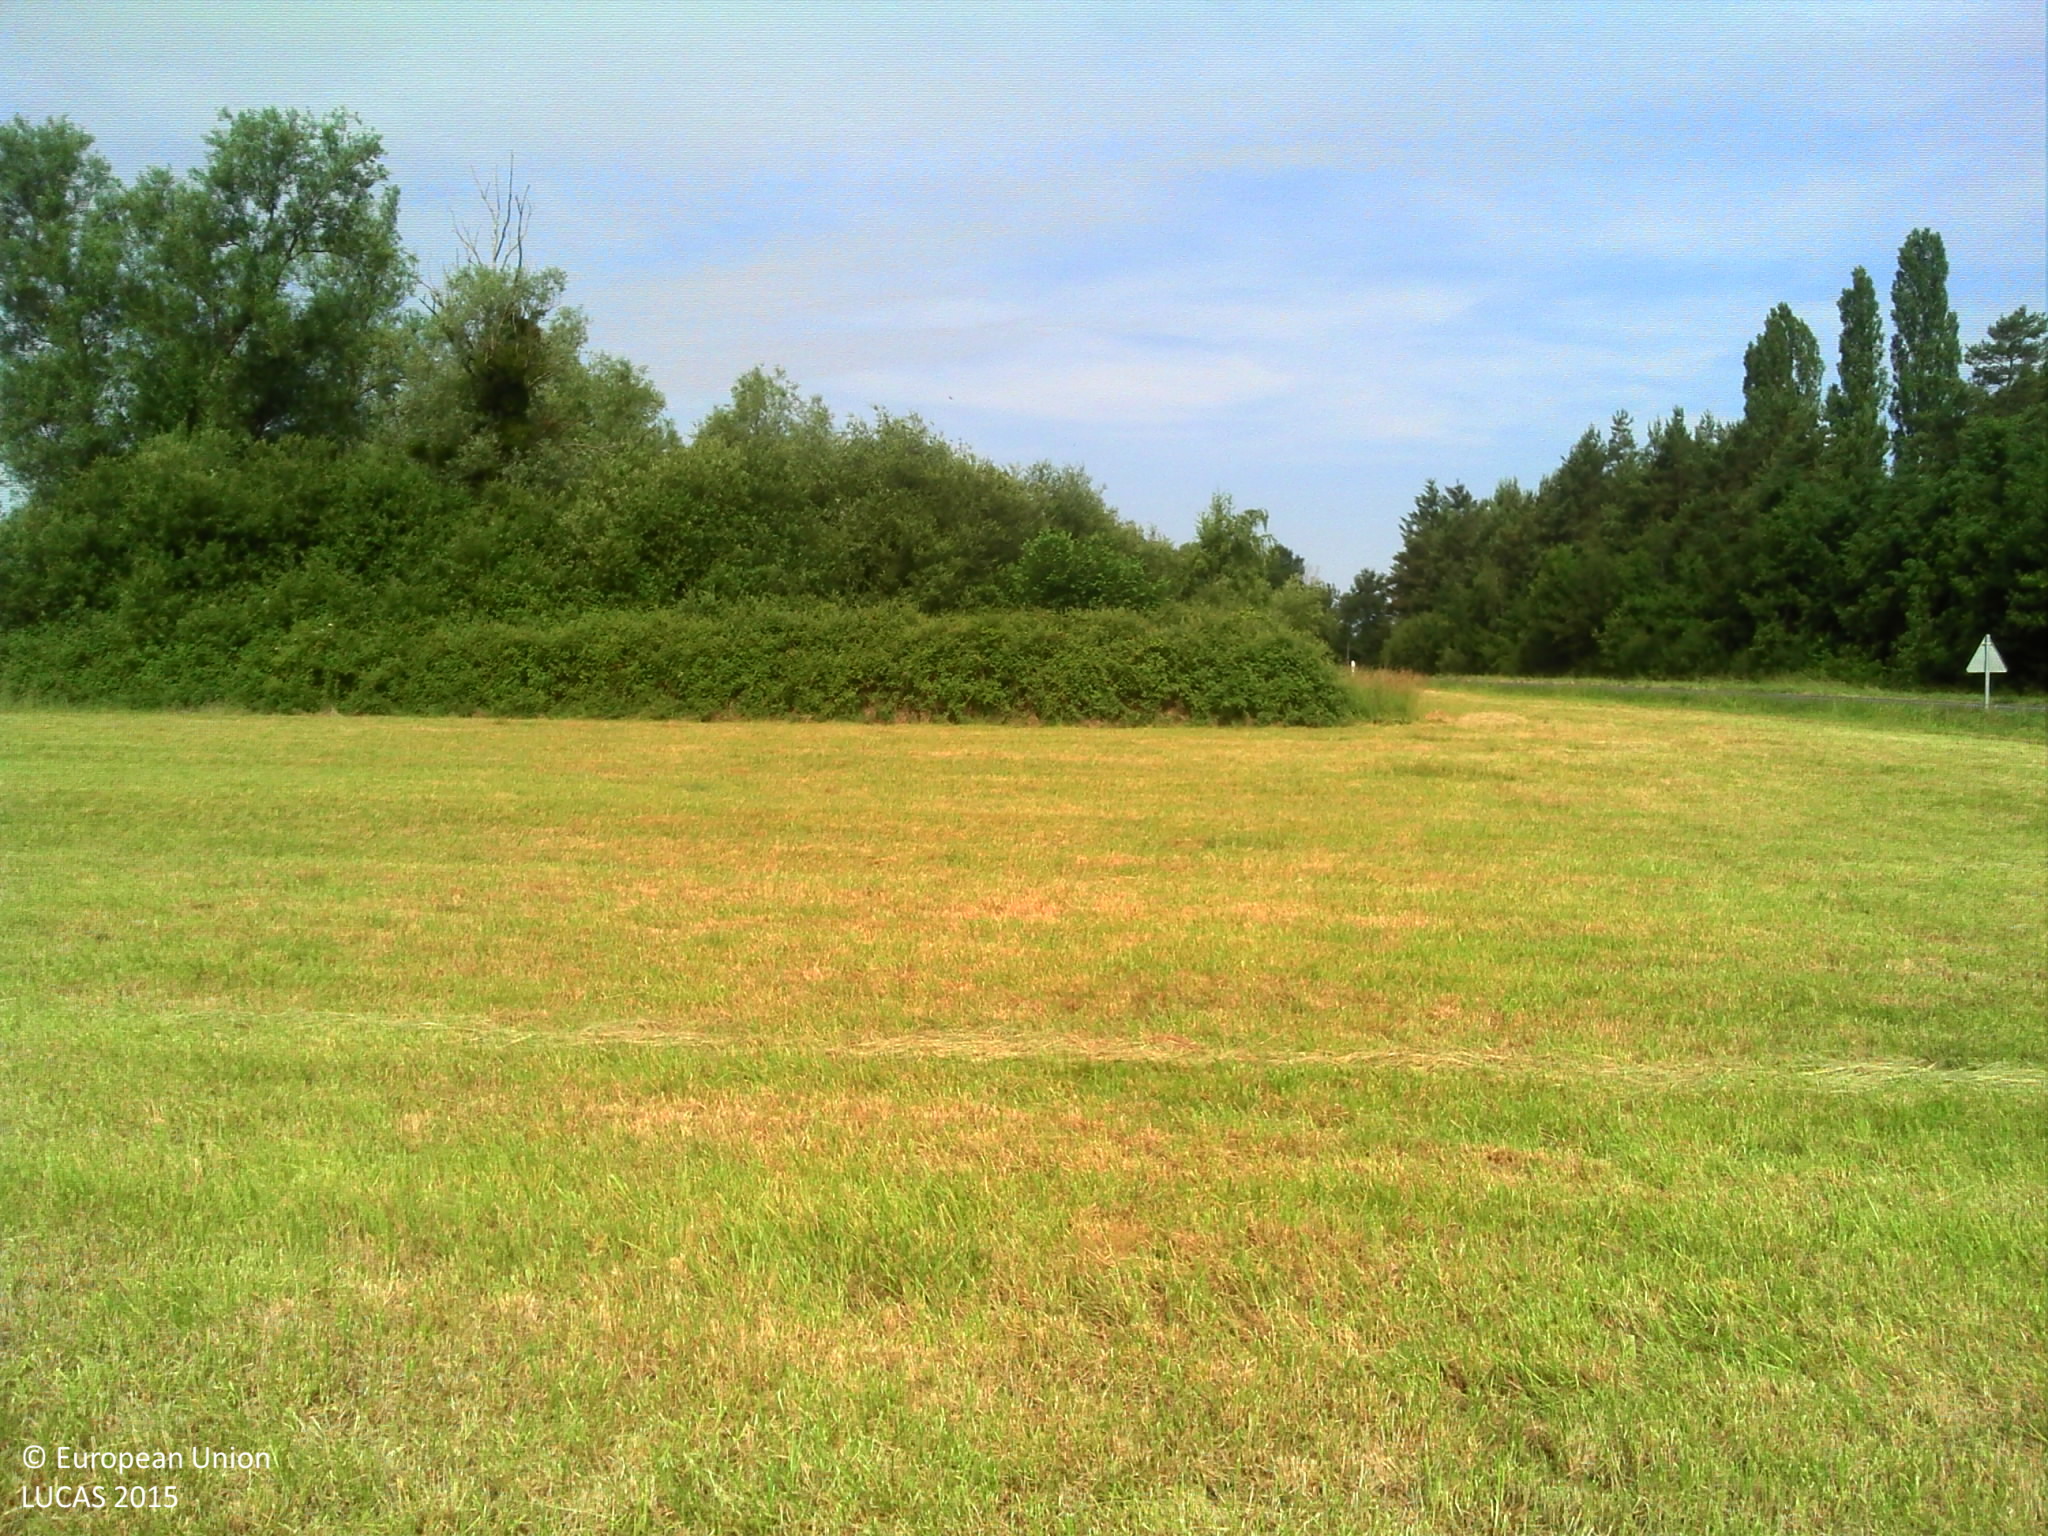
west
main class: Grassland
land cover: Grassland without tree/shrub cover
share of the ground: > 75 %
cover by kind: herbaceous plants 100 %
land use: Agriculture (excluding fallow land and kitchen gardens)
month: June
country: FR
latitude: 47.4950
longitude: 1.4774
